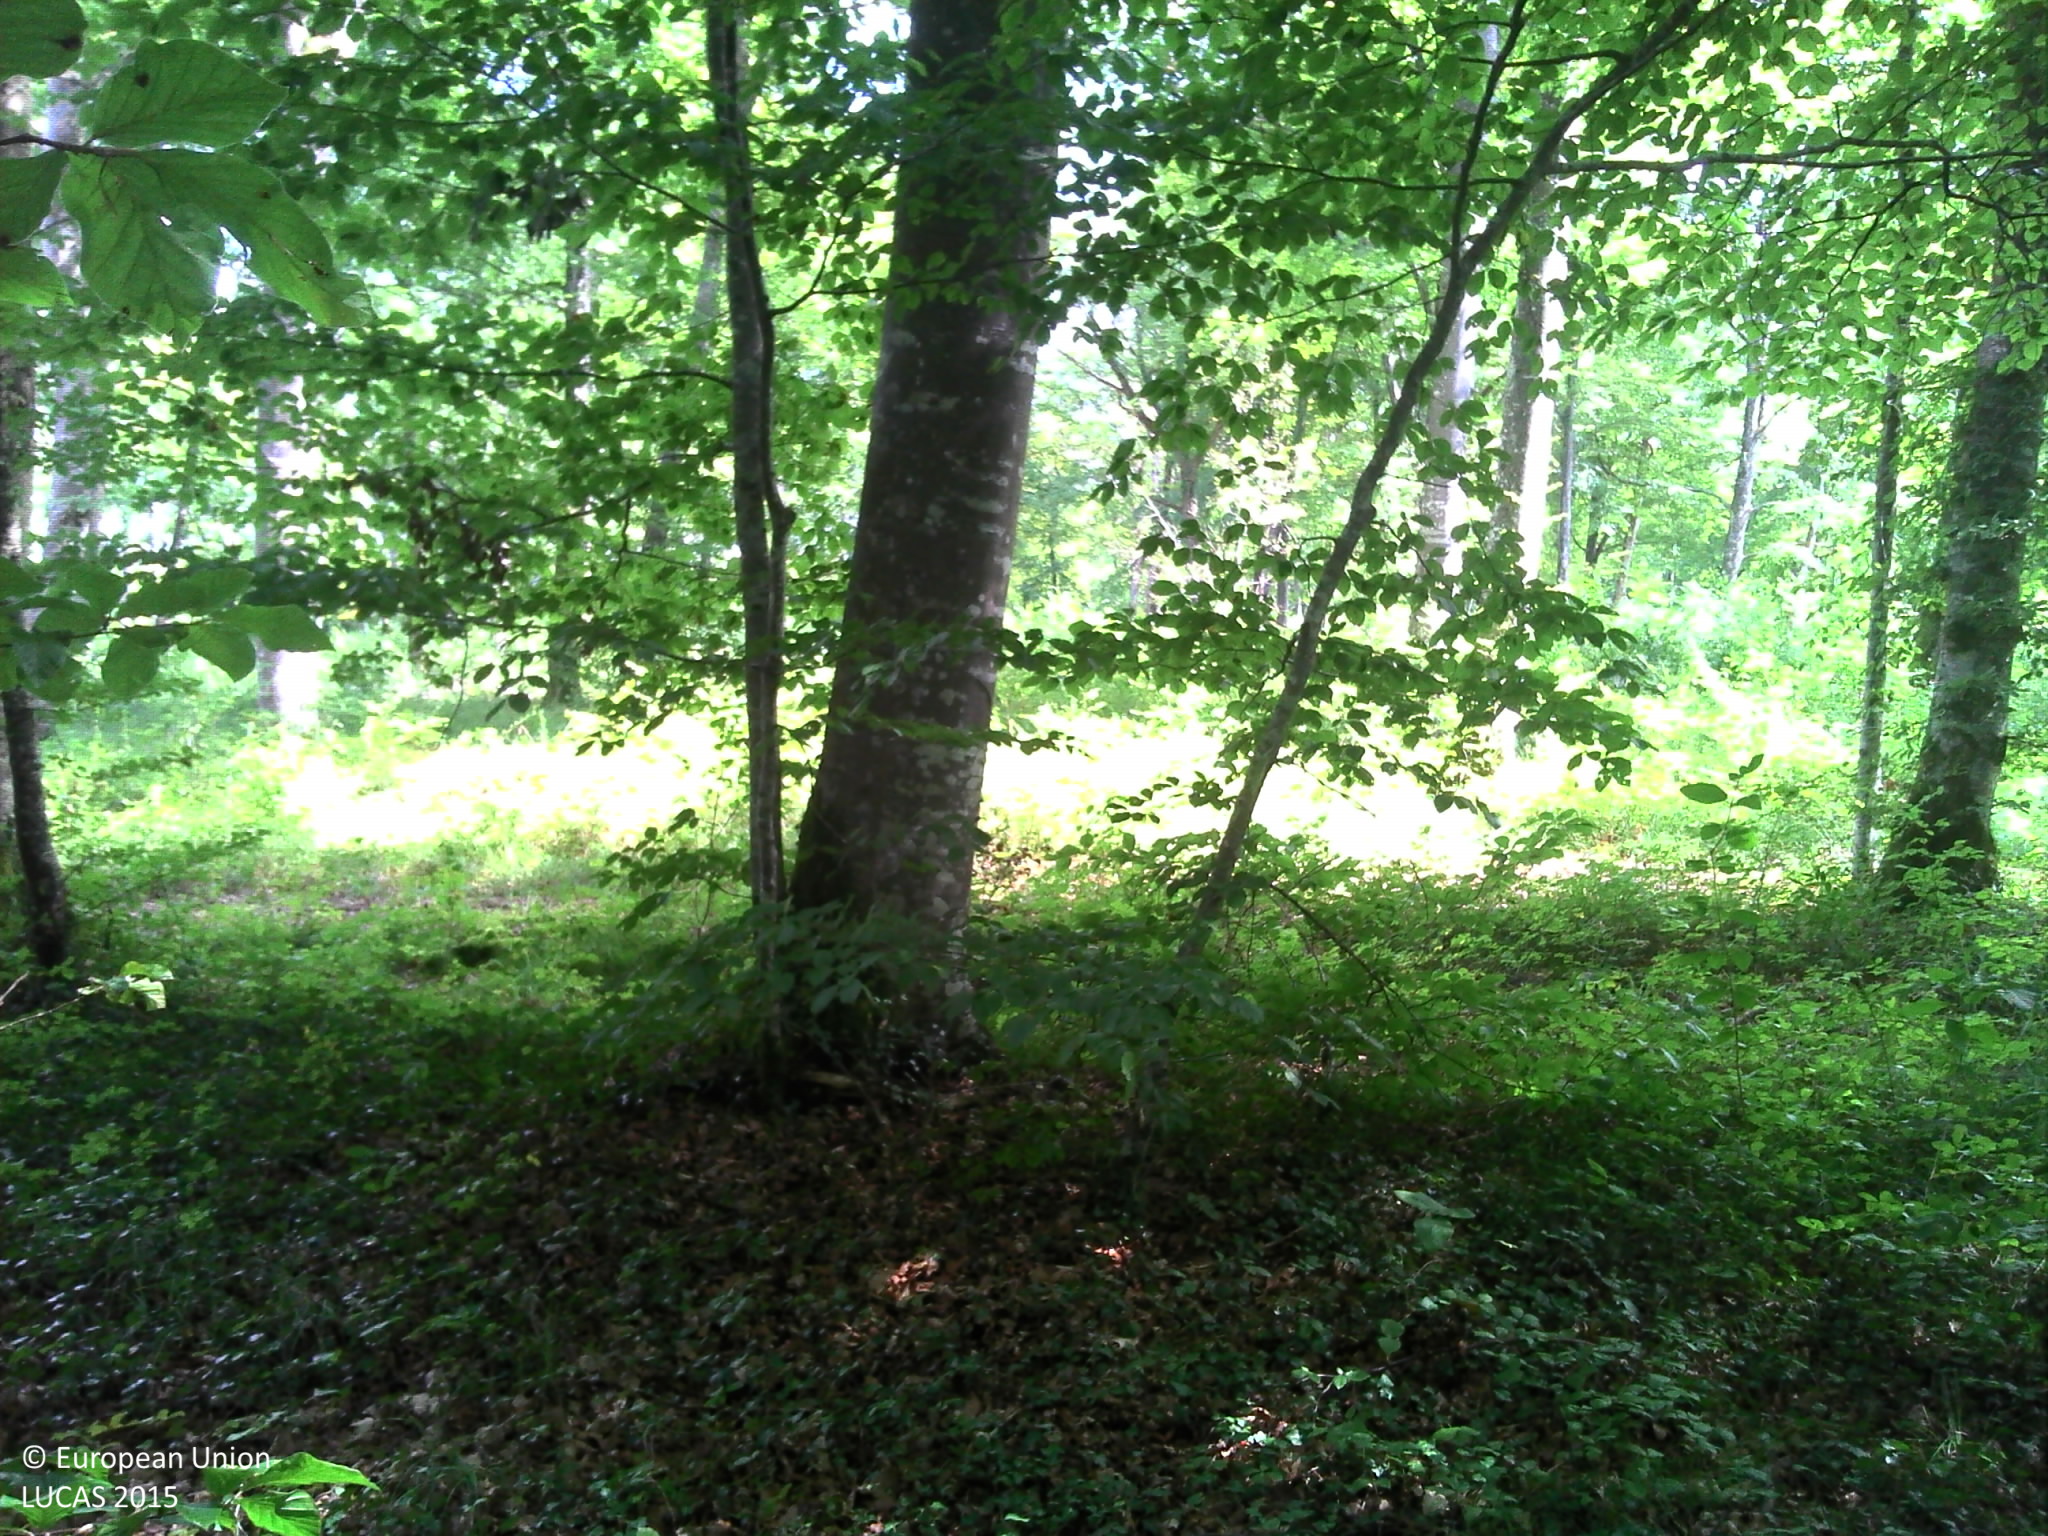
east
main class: Woodland
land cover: Broadleaved woodland
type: mesophytic deciduous forest
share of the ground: > 75 %
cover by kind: broadleaved forest trees 80 %, shrubs 10 %, herbaceous plants 10 %
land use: Forestry
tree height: > 5 m
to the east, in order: Broadleaved woodland; Tracks; Broadleaved woodland; Tracks; Broadleaved woodland
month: September
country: FR
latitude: 47.4844
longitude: 4.7309
